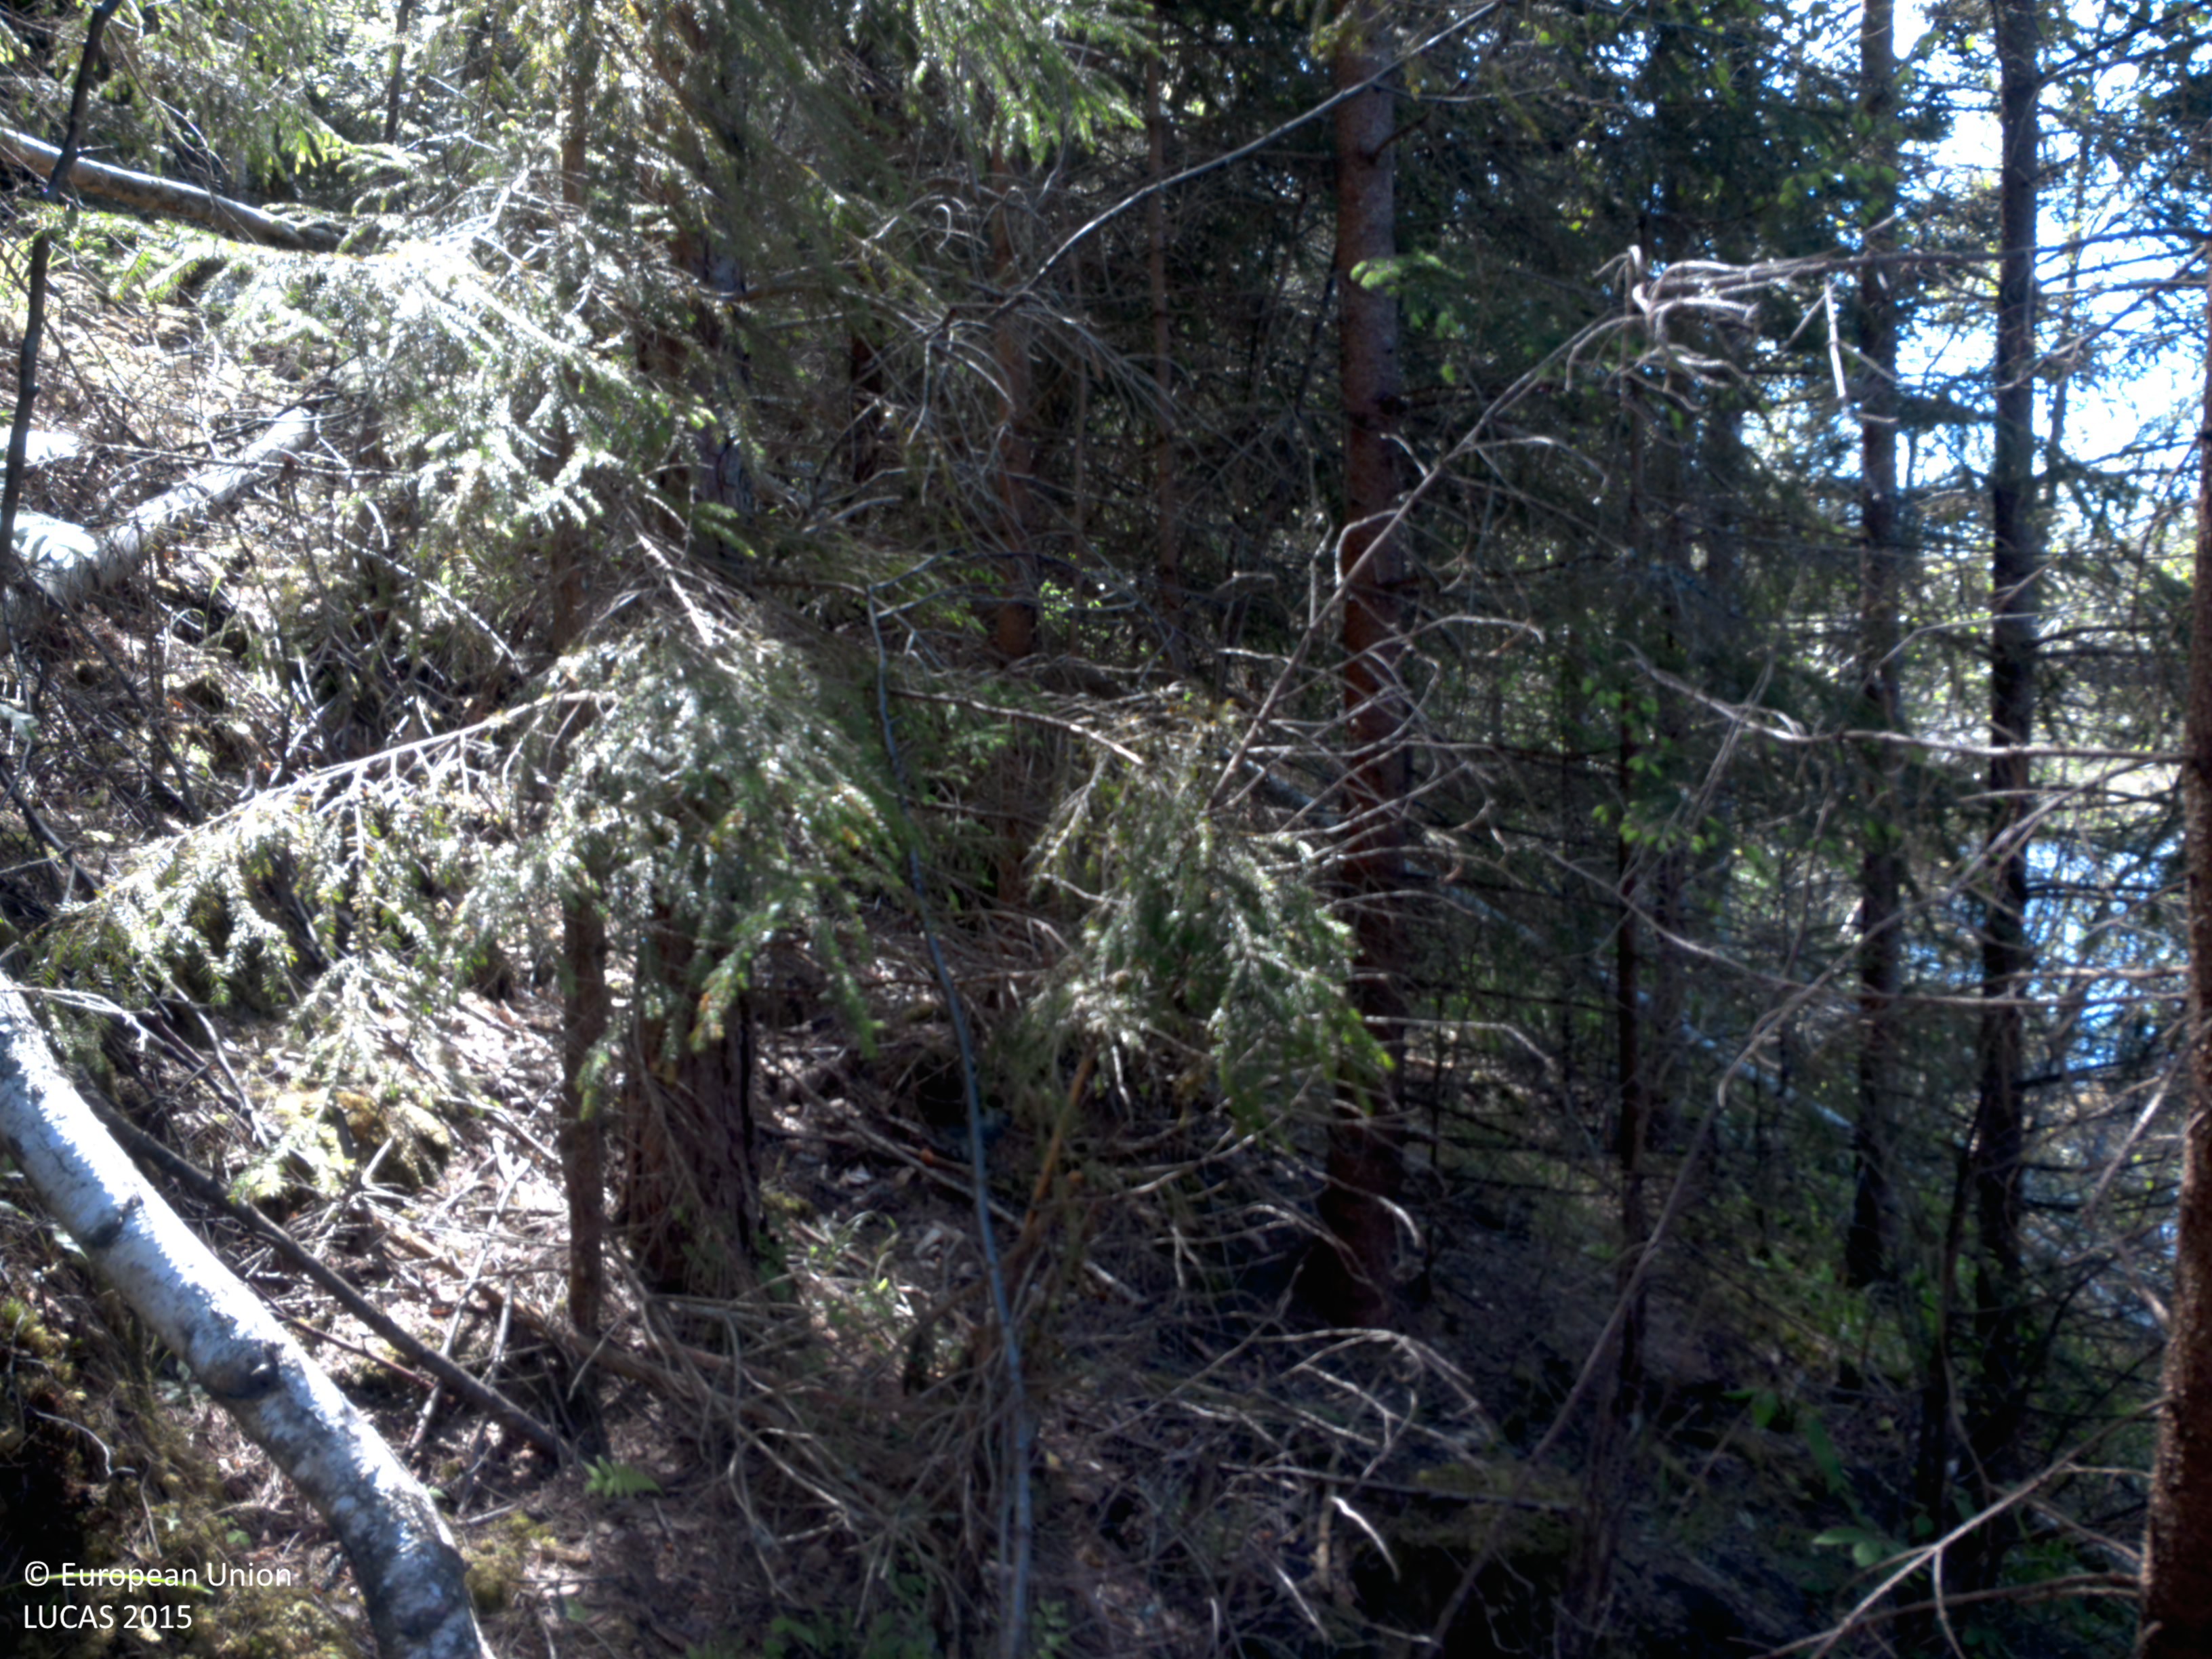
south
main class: Woodland
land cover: Spruce dominated mixed woodland
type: boreal forest
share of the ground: > 75 %
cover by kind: coniferous forest trees 60 %, broadleaved forest trees 25 %, herbaceous plants 10 %, shrubs 5 %
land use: Forestry
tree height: > 5 m
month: June
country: SE
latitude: 59.0988
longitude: 12.3513
